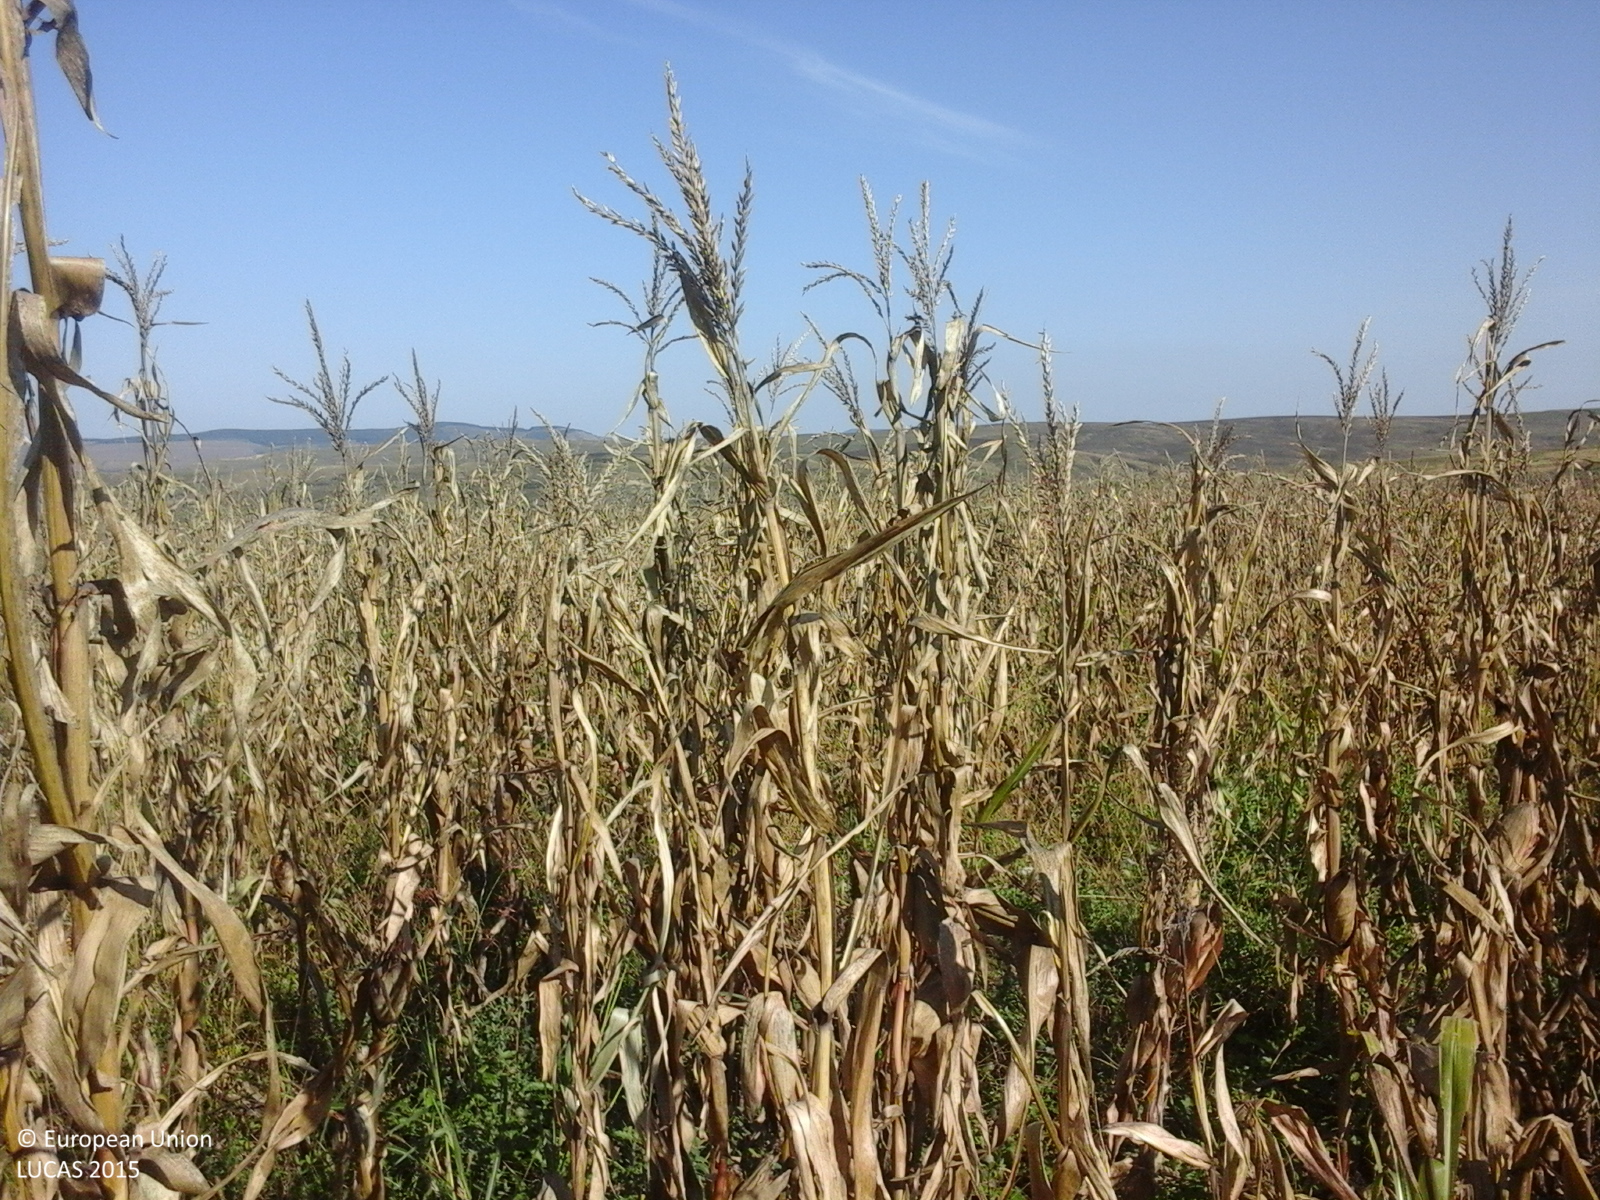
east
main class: Cropland
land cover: Maize
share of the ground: > 75 %
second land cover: Spontaneously vegetated surfaces
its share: > 75 %
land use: Agriculture (excluding fallow land and kitchen gardens)
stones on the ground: < 10 %
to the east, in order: Maize; Spontaneously vegetated surfaces; Grassland with sparse tree/shrub cover; Spontaneously vegetated surfaces
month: October
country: RO
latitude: 46.1479
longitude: 23.7813
